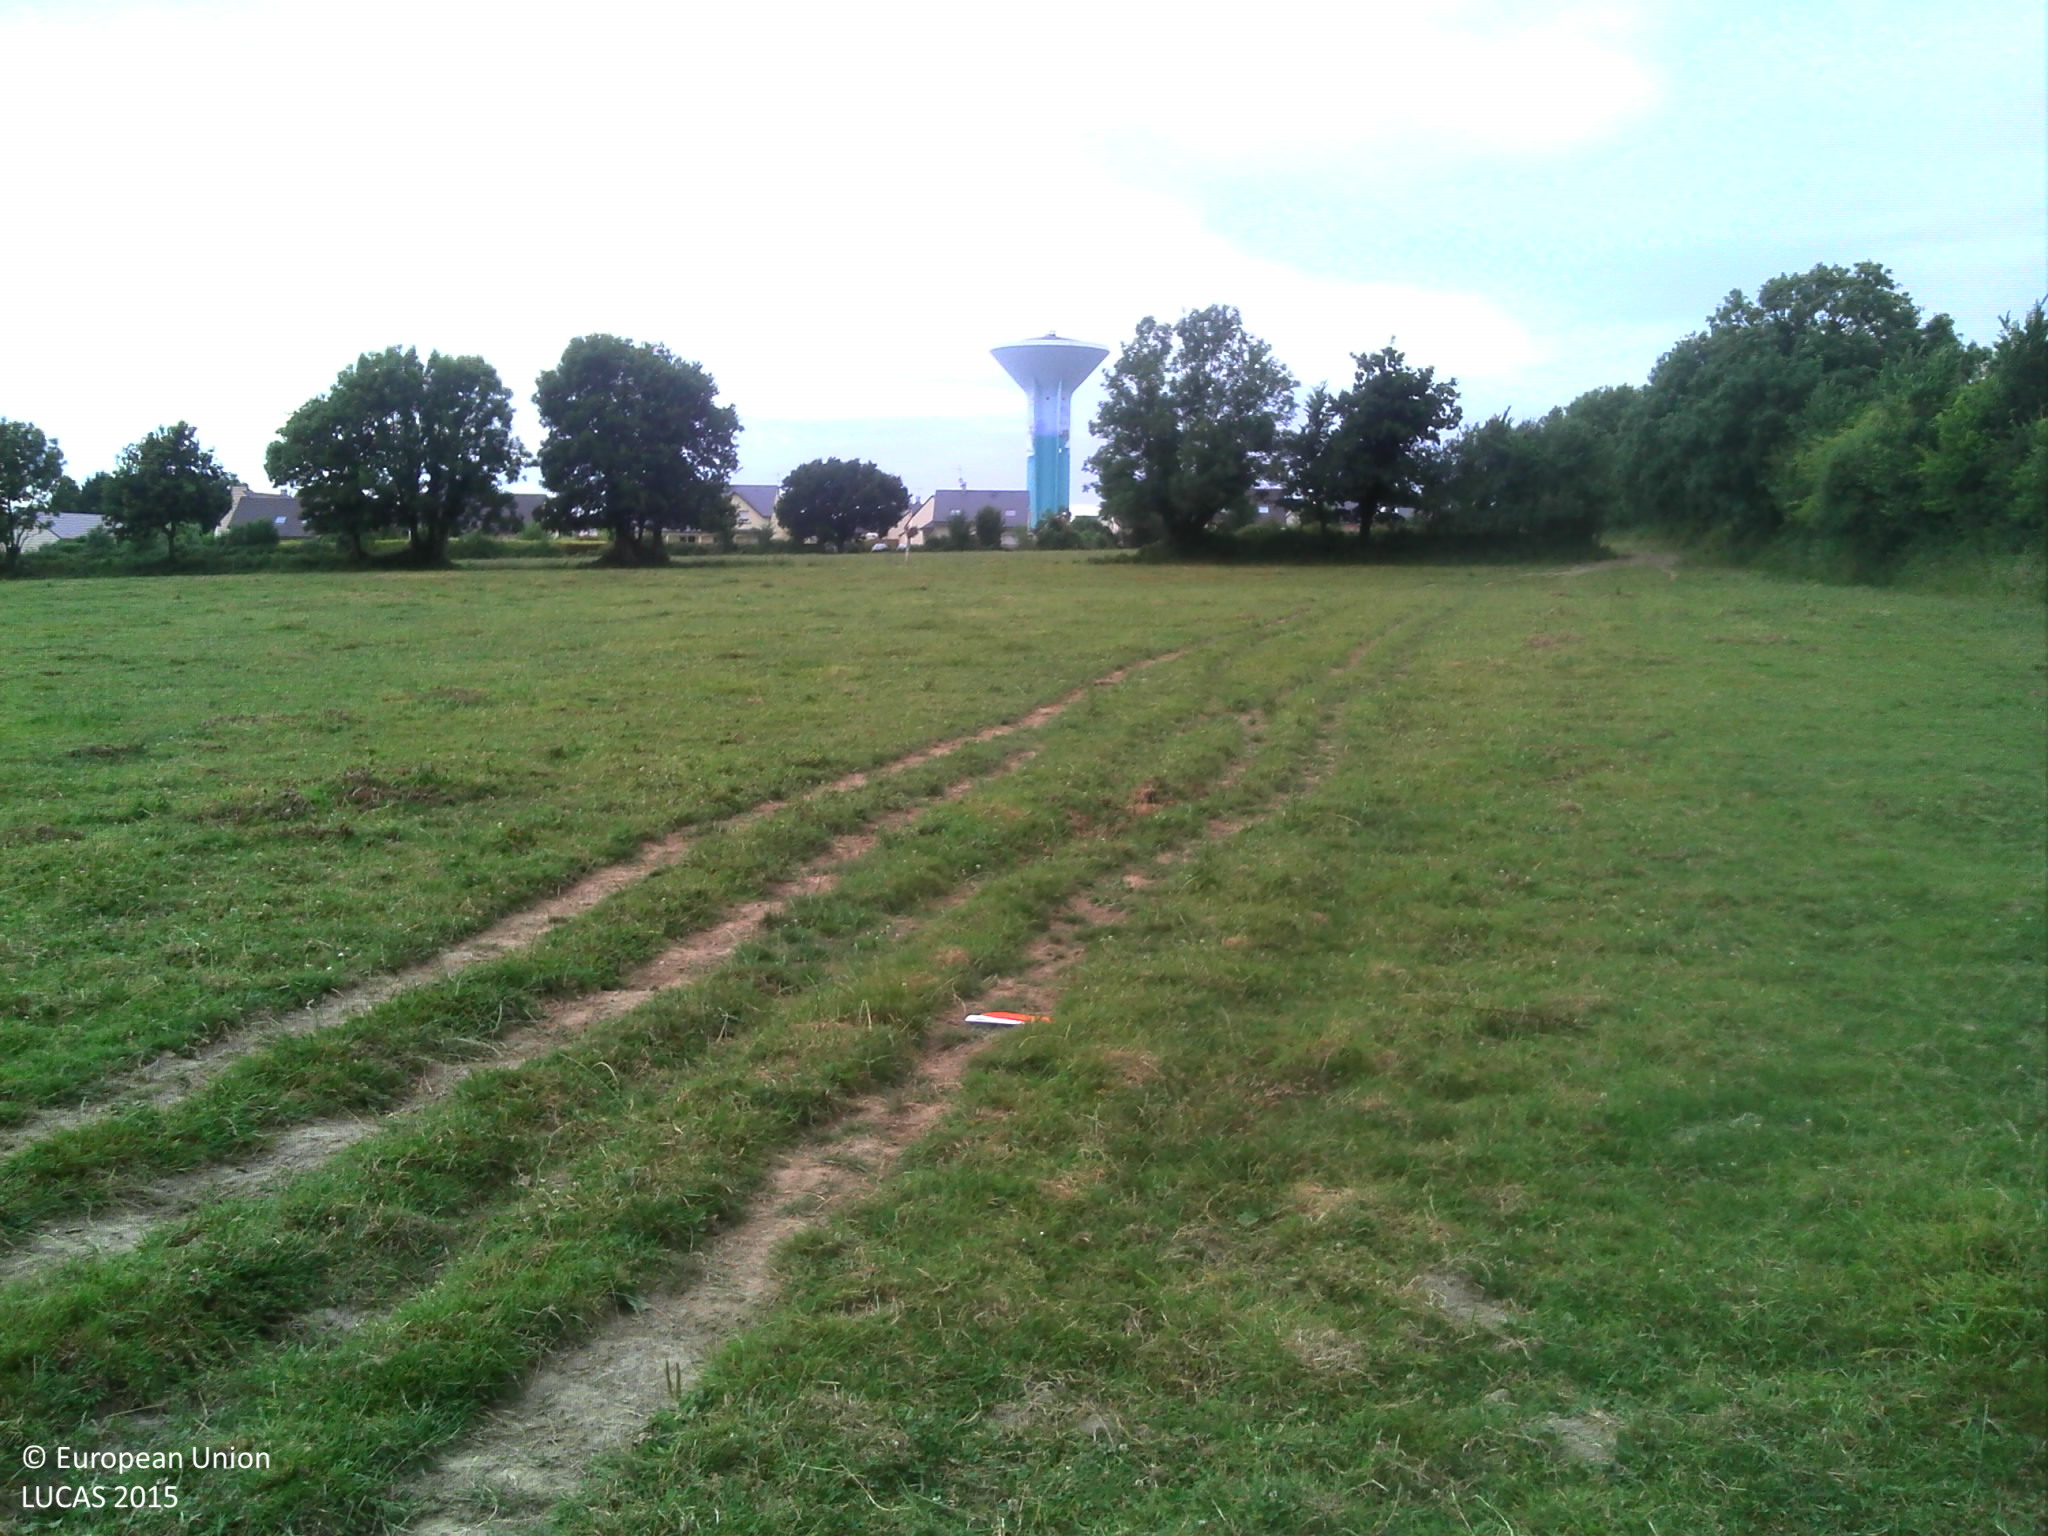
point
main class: Grassland
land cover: Grassland without tree/shrub cover
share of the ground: > 75 %
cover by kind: herbaceous plants 100 %
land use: Agriculture (excluding fallow land and kitchen gardens)
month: July
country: FR
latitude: 48.8308
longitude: -1.5600
